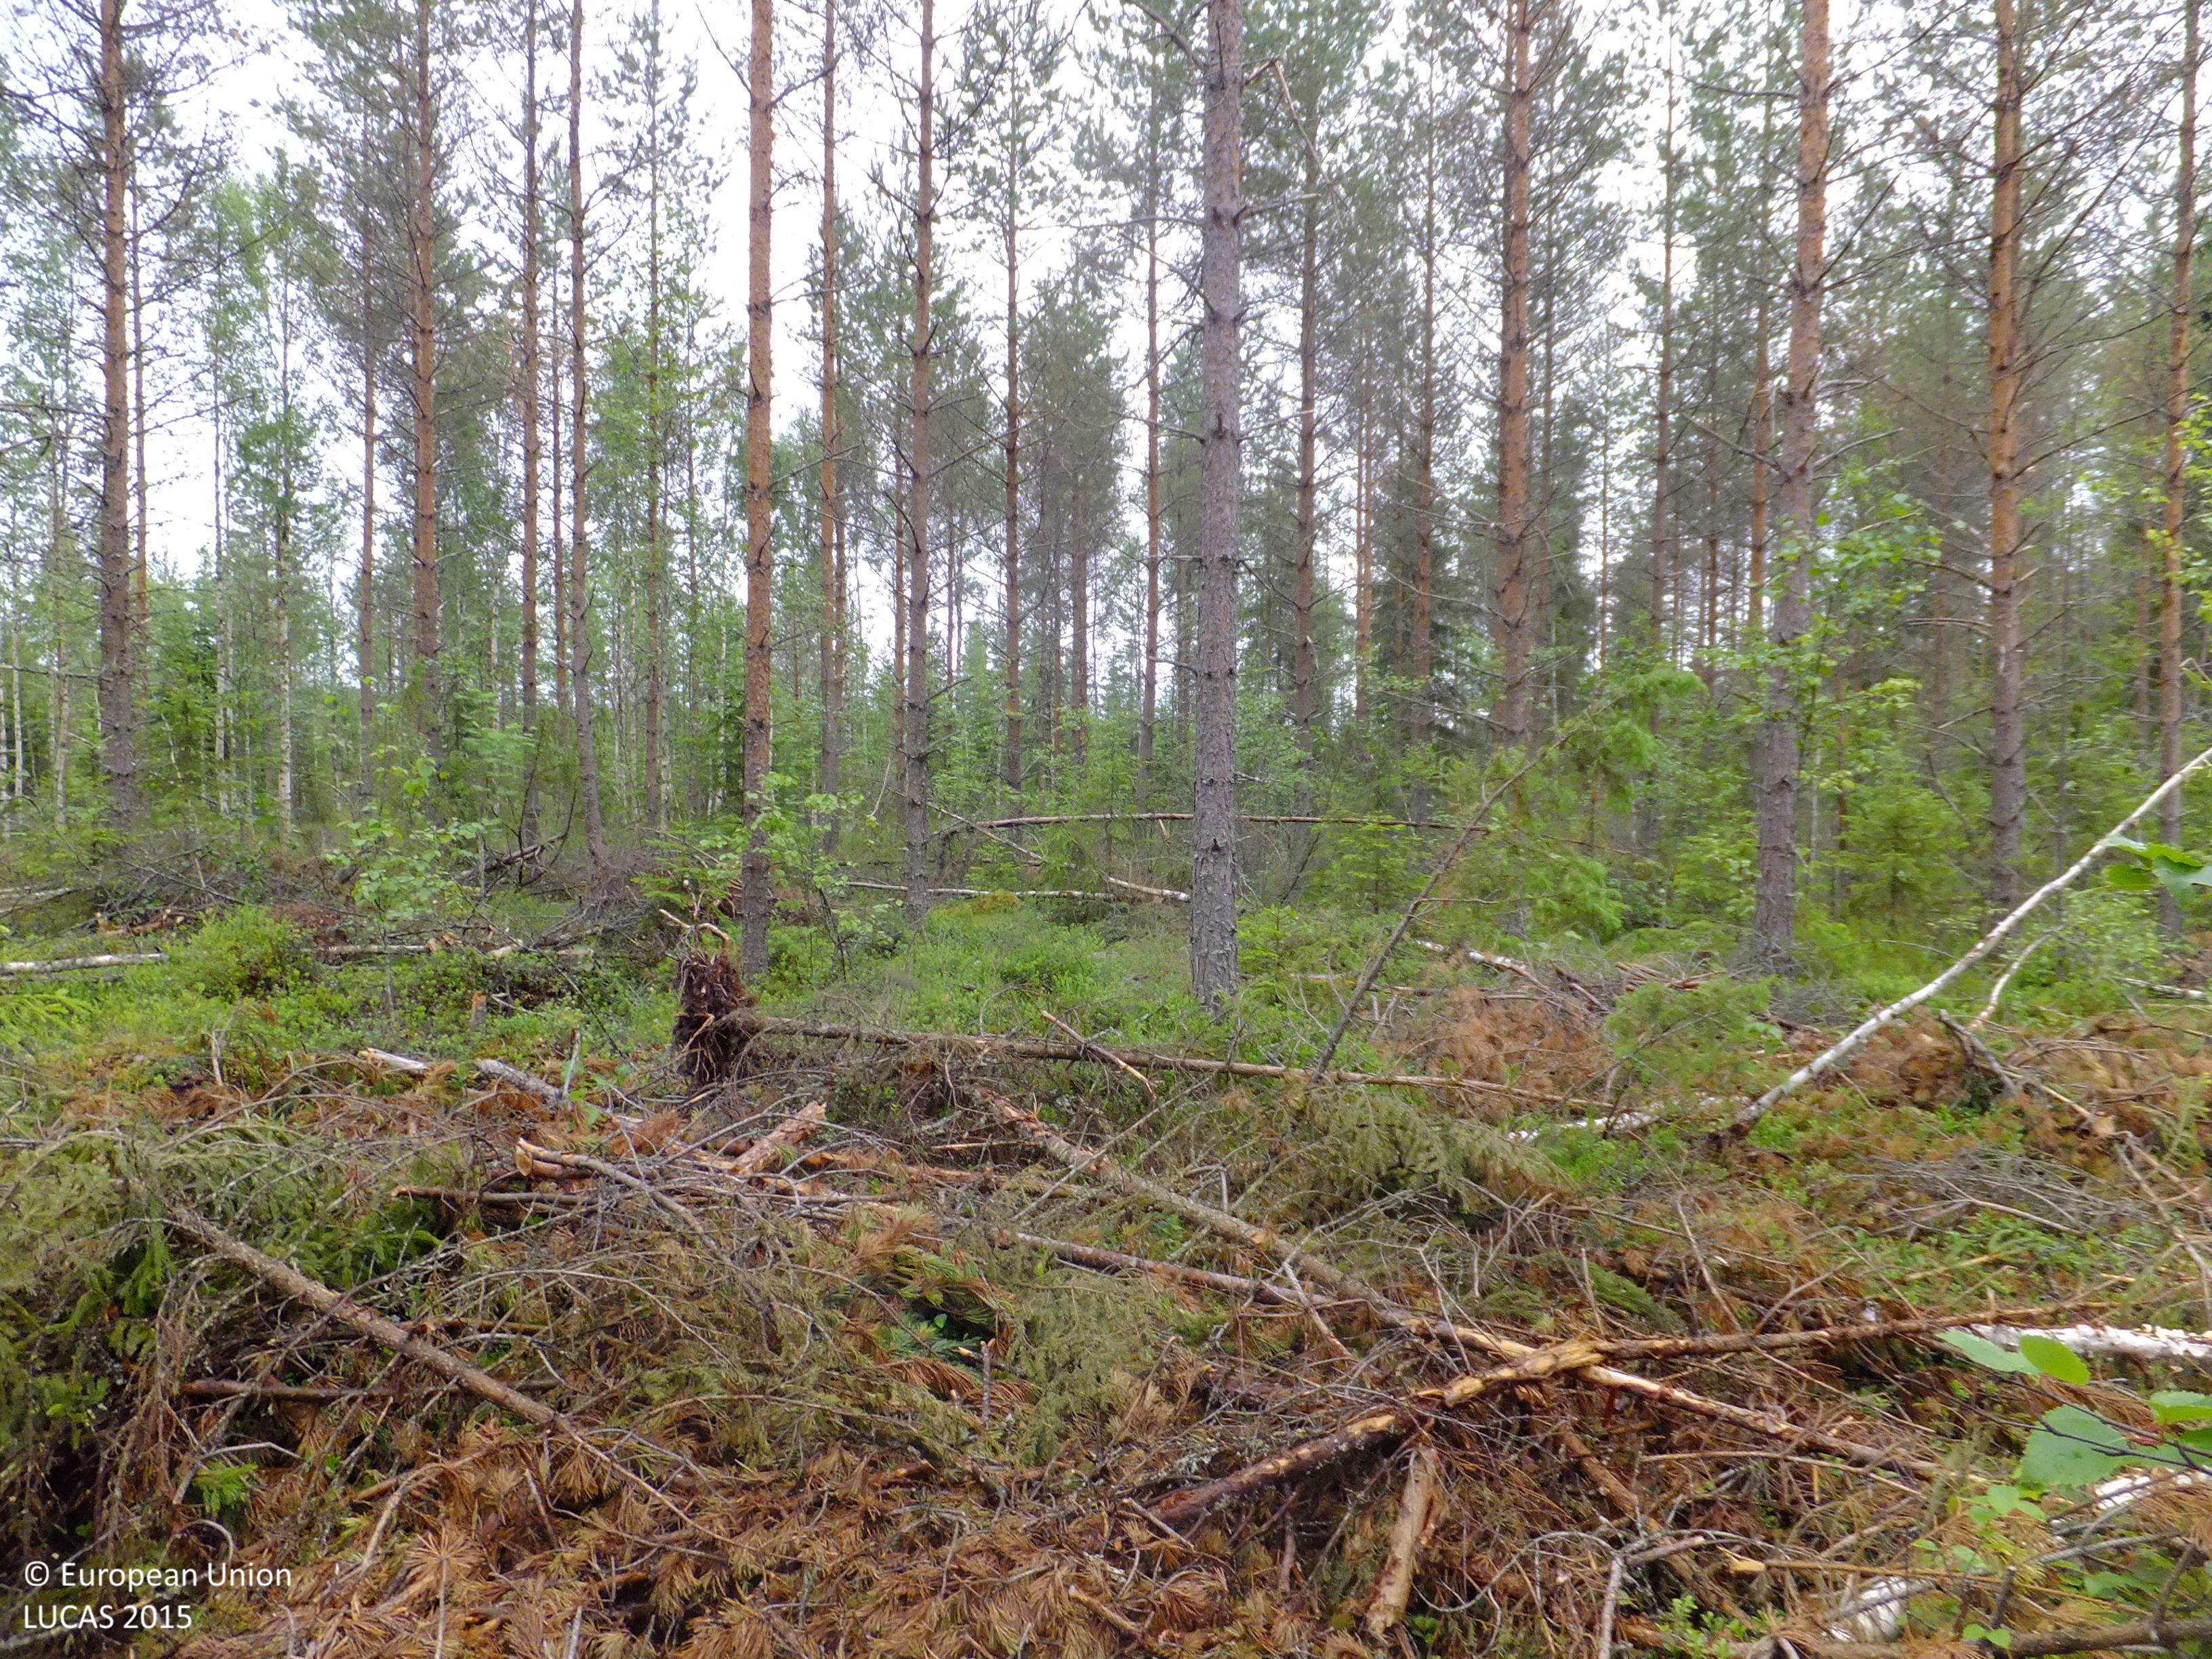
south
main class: Woodland
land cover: Other coniferous woodland
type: boreal forest
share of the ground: > 75 %
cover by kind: coniferous forest trees 70 %, broadleaved forest trees 10 %, shrubs 10 %, herbaceous plants 5 %, lichens and mosses 5 %
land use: Forestry
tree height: > 5 m
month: July
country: FI
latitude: 63.1689
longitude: 24.5613
